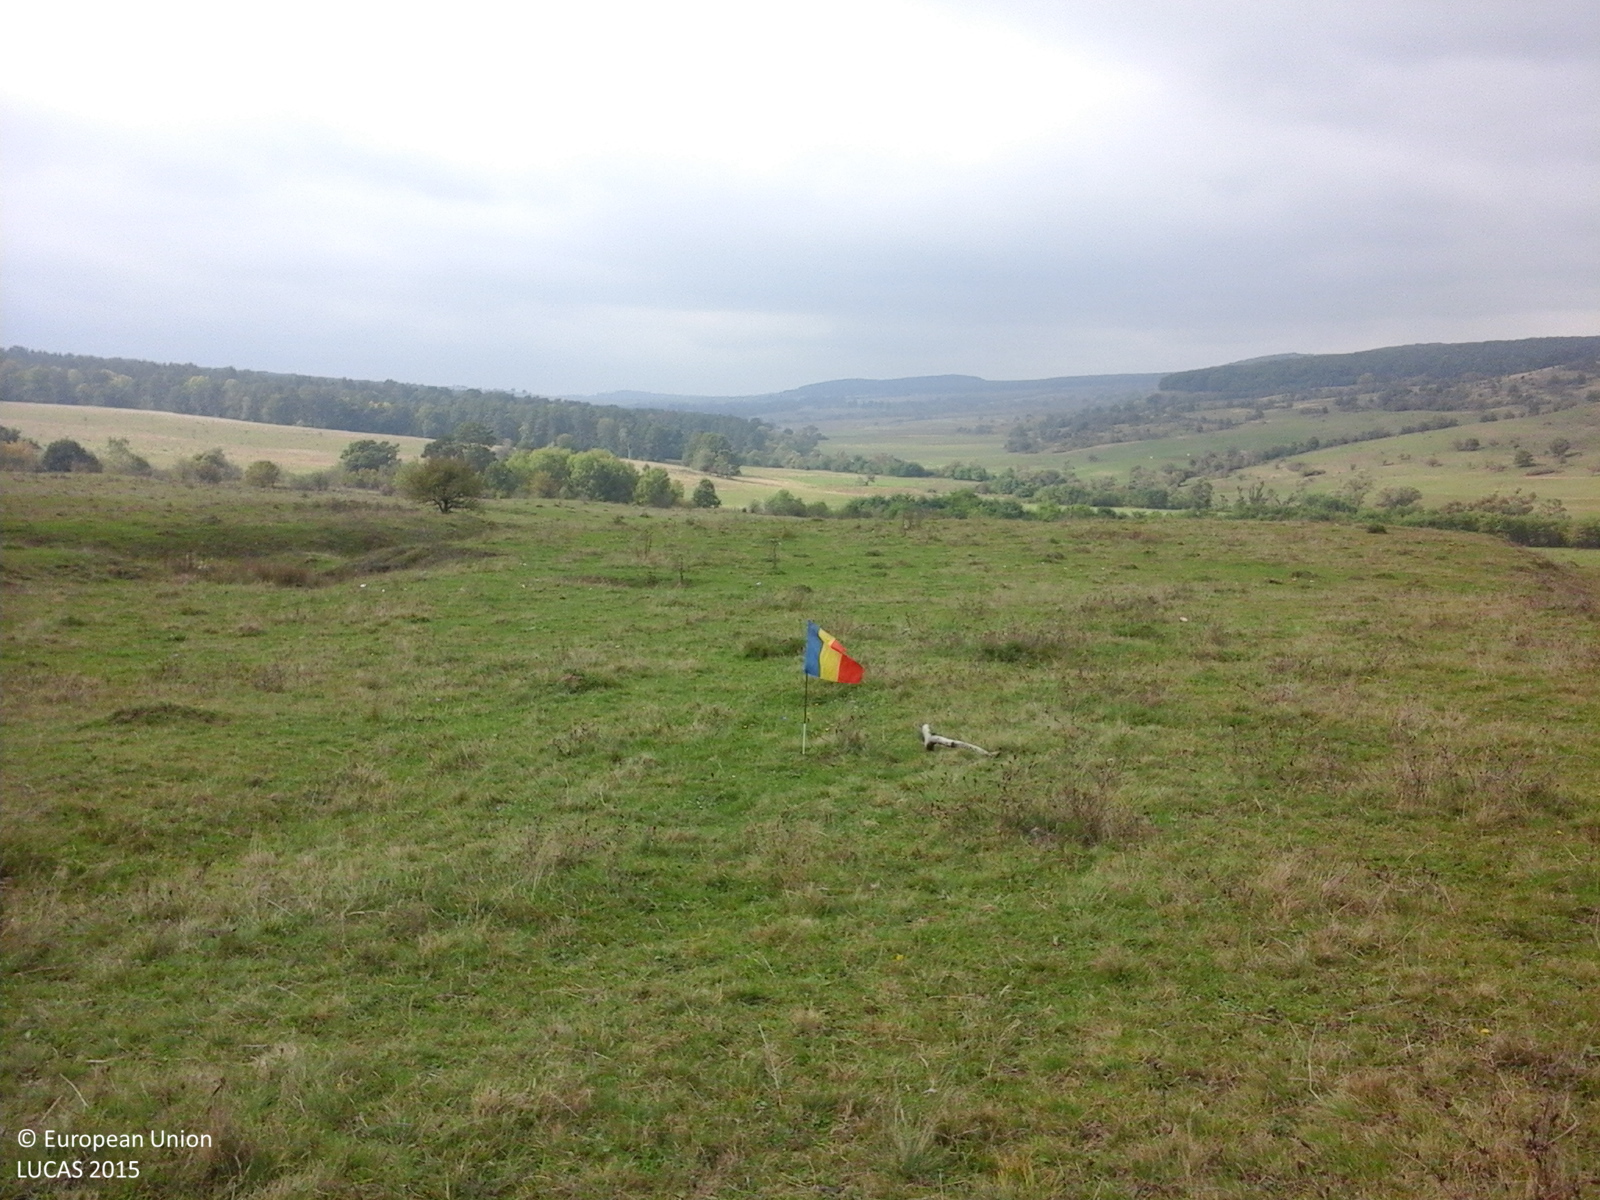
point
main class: Grassland
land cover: Grassland without tree/shrub cover
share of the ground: > 75 %
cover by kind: herbaceous plants 100 %
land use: Agriculture (excluding fallow land and kitchen gardens)
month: October
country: RO
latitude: 45.9382
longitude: 25.1750
